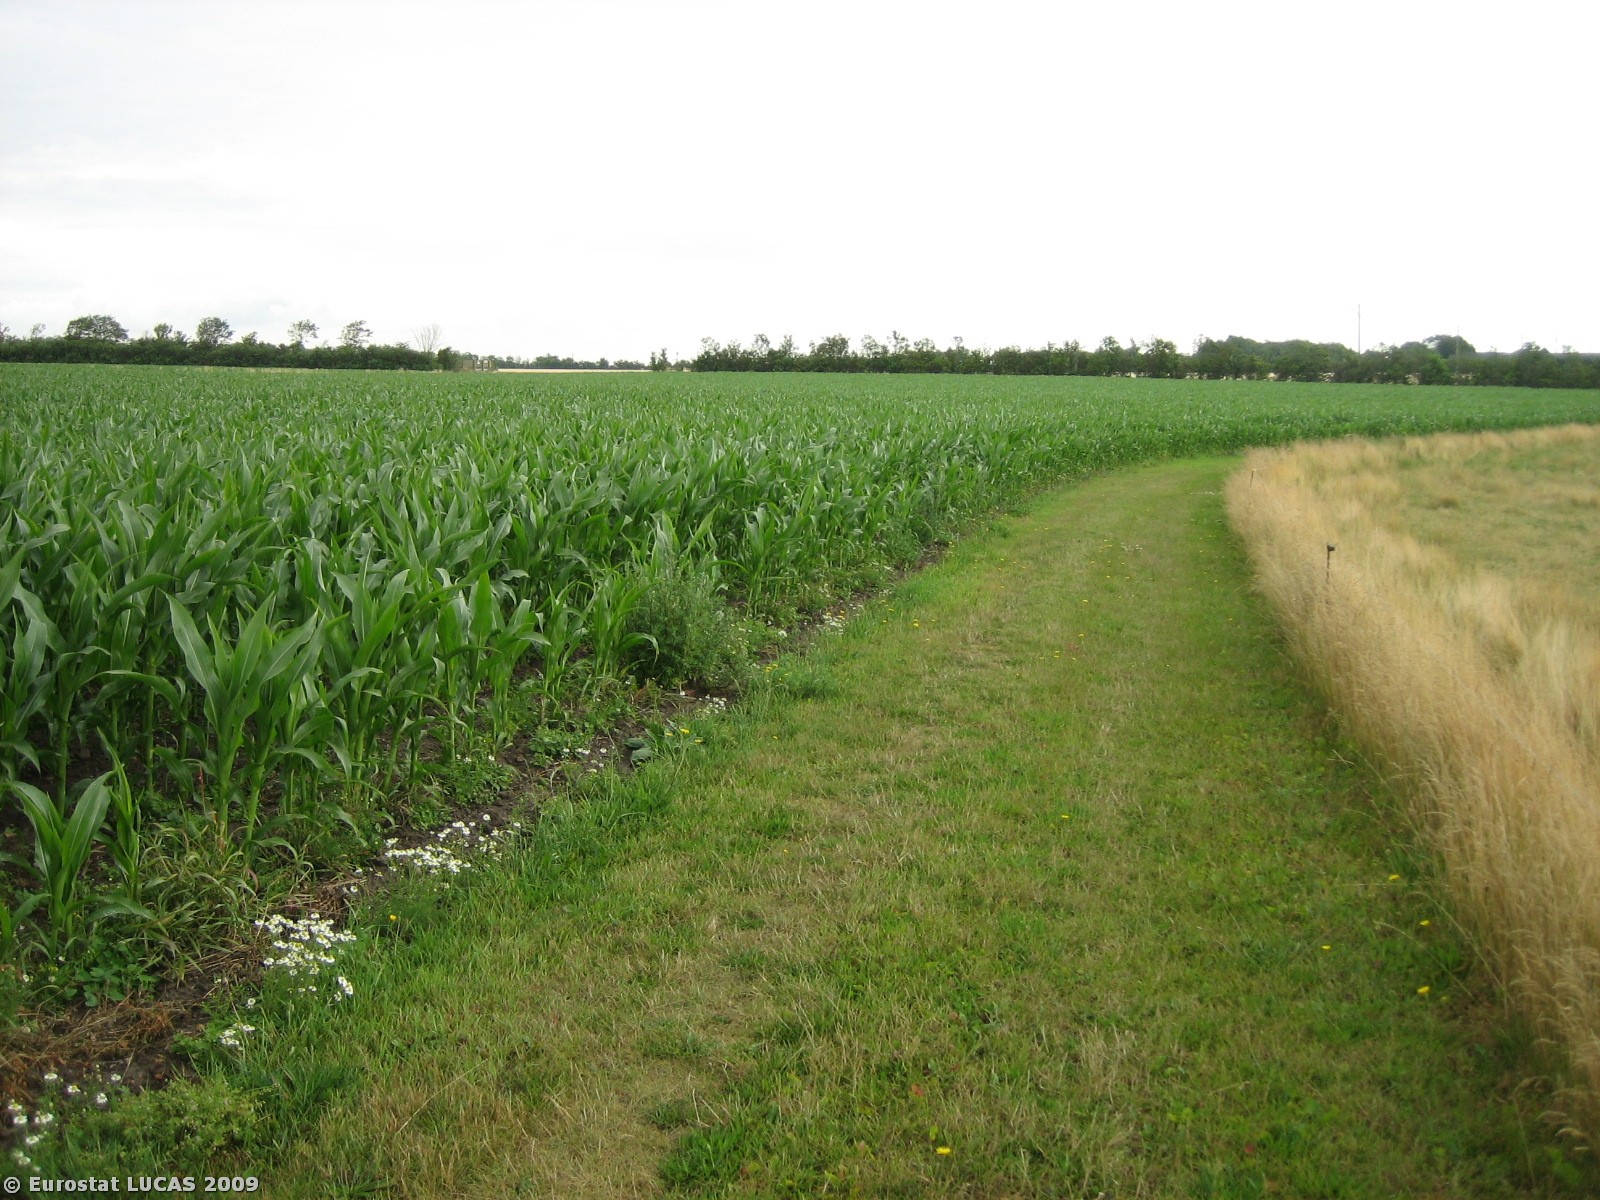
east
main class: Grassland
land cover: Grassland without tree/shrub cover
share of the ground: > 75 %
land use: Agriculture (excluding fallow land and kitchen gardens)
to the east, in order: Grassland without tree/shrub cover; Fences; Tracks; Maize; Broadleaved woodland; Barley
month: July
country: DK
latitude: 55.7638
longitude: 8.3600
